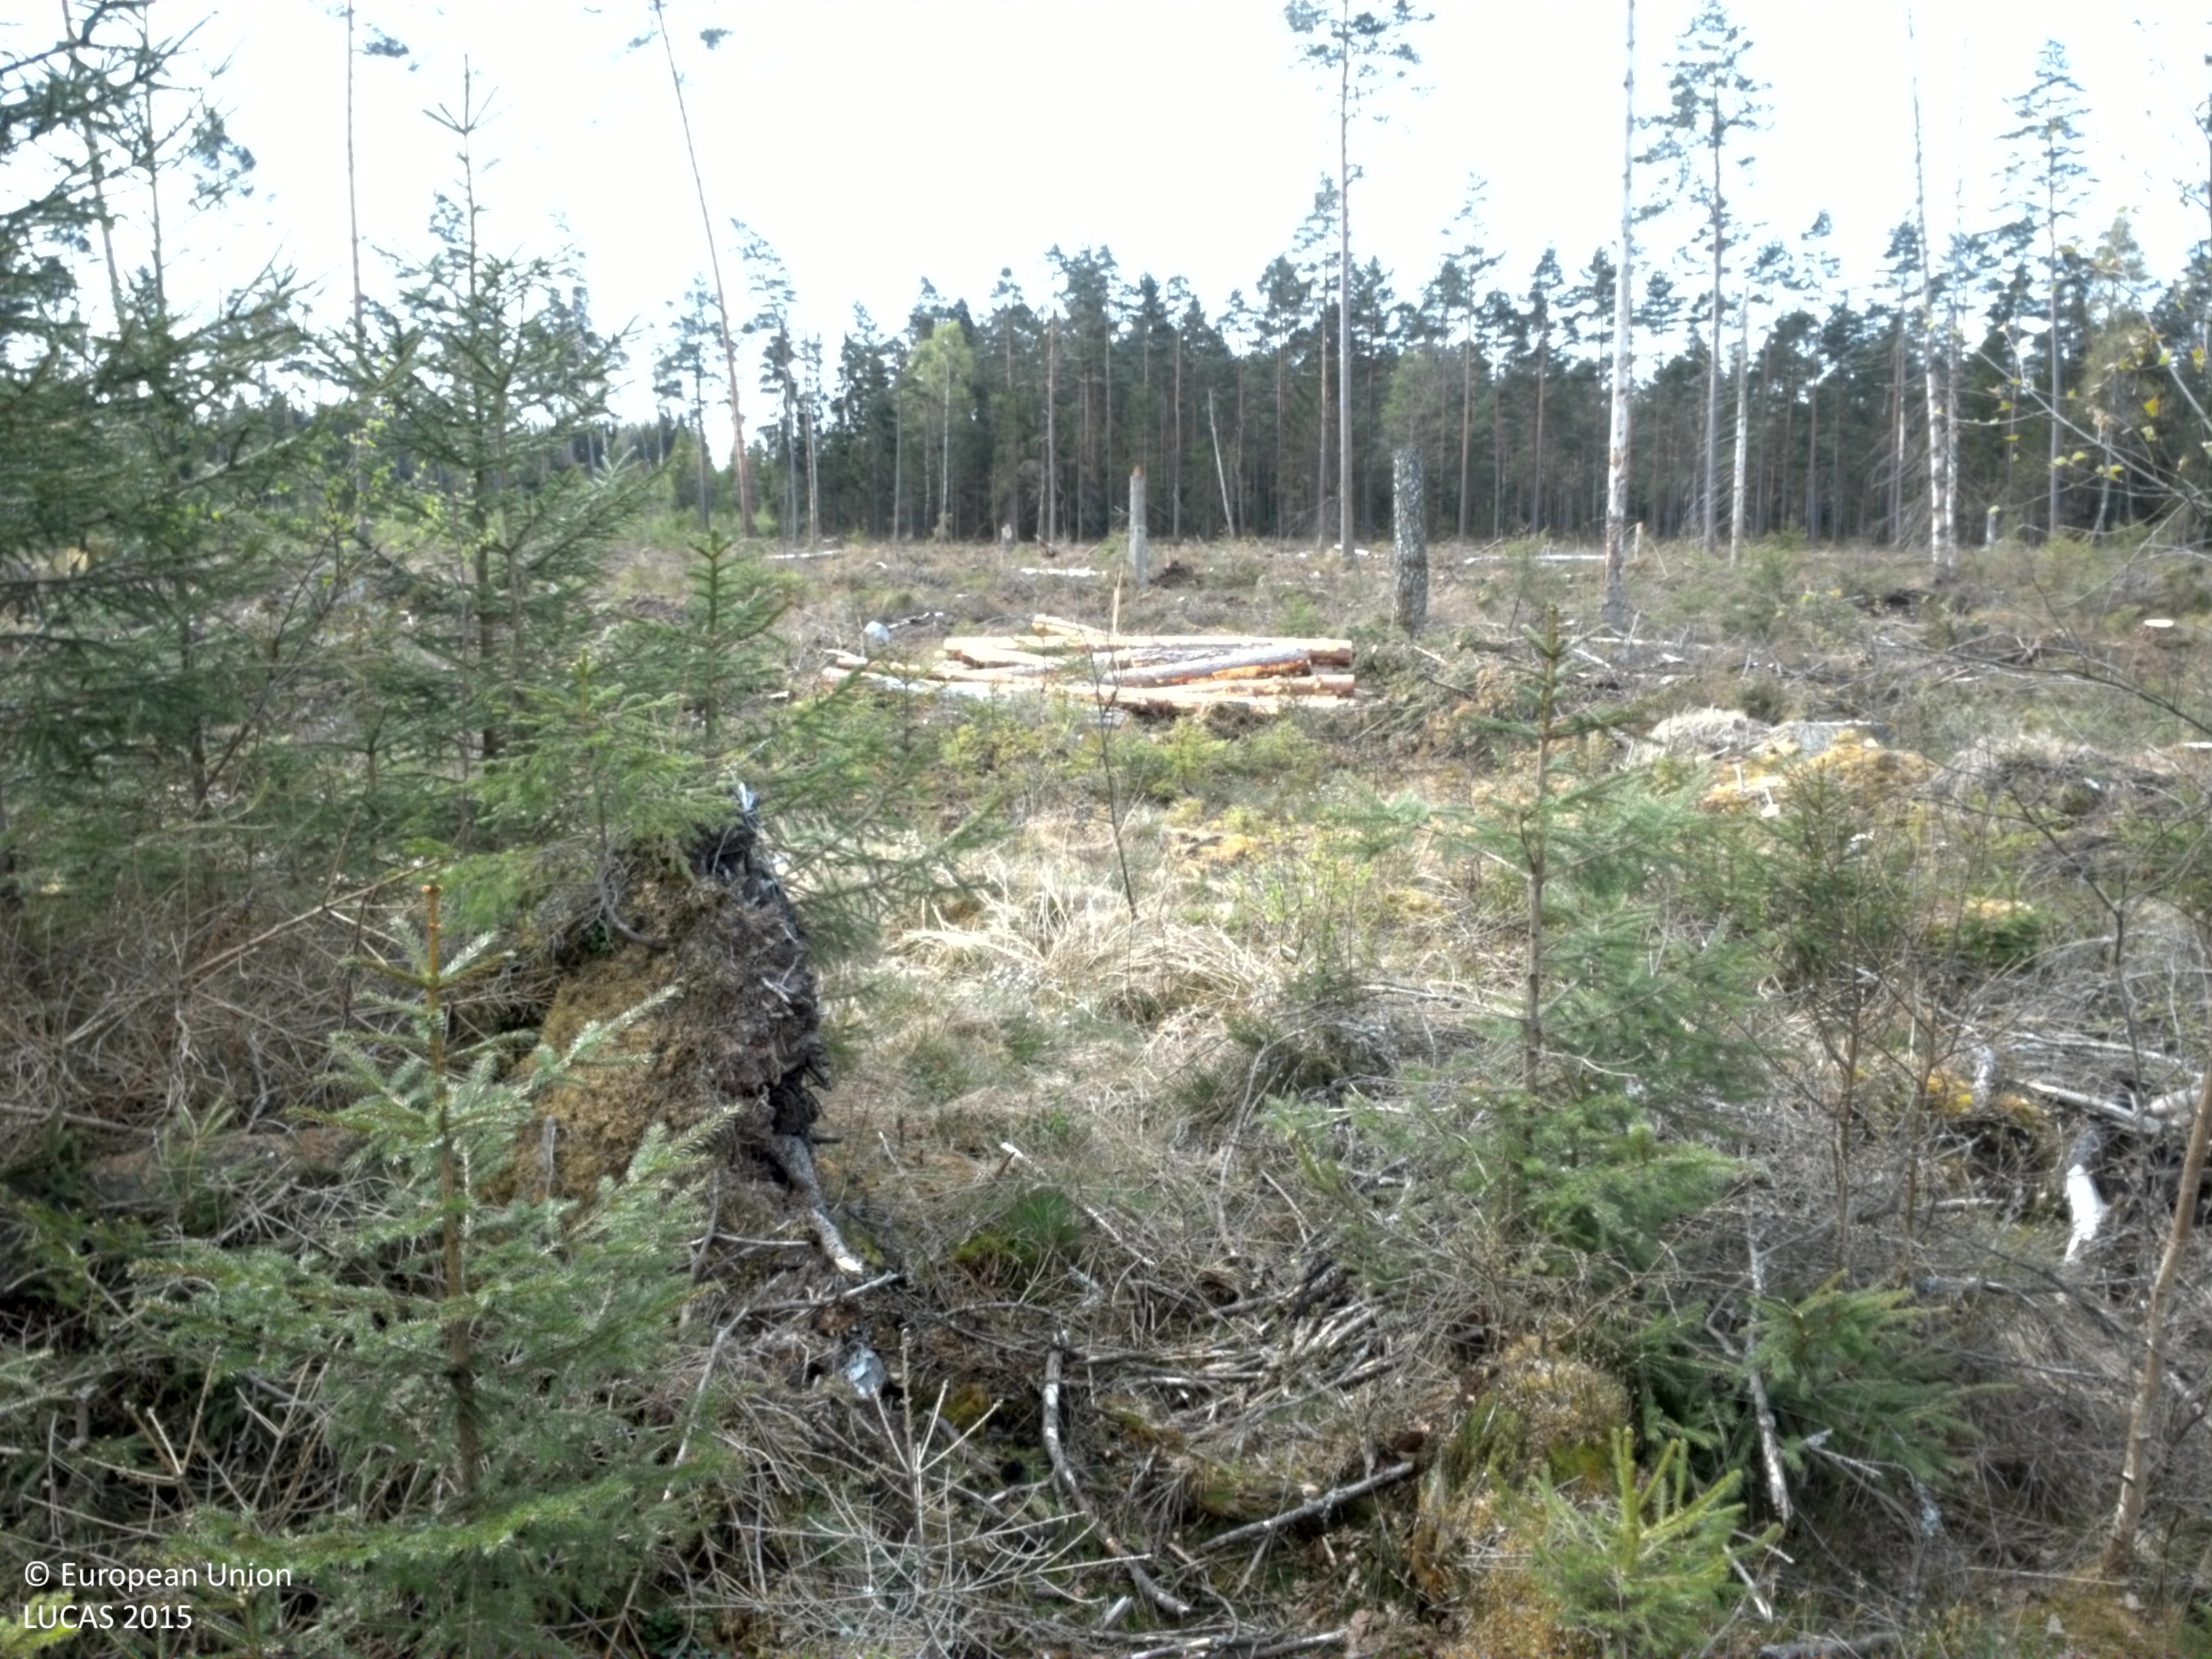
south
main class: Woodland
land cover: Spruce dominated coniferous woodland
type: boreal forest
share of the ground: > 75 %
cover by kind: coniferous forest trees 65 %, herbaceous plants 15 %, broadleaved forest trees 10 %, shrubs 10 %
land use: Forestry
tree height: < 5 m
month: May
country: SE
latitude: 56.8019
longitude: 14.7626
